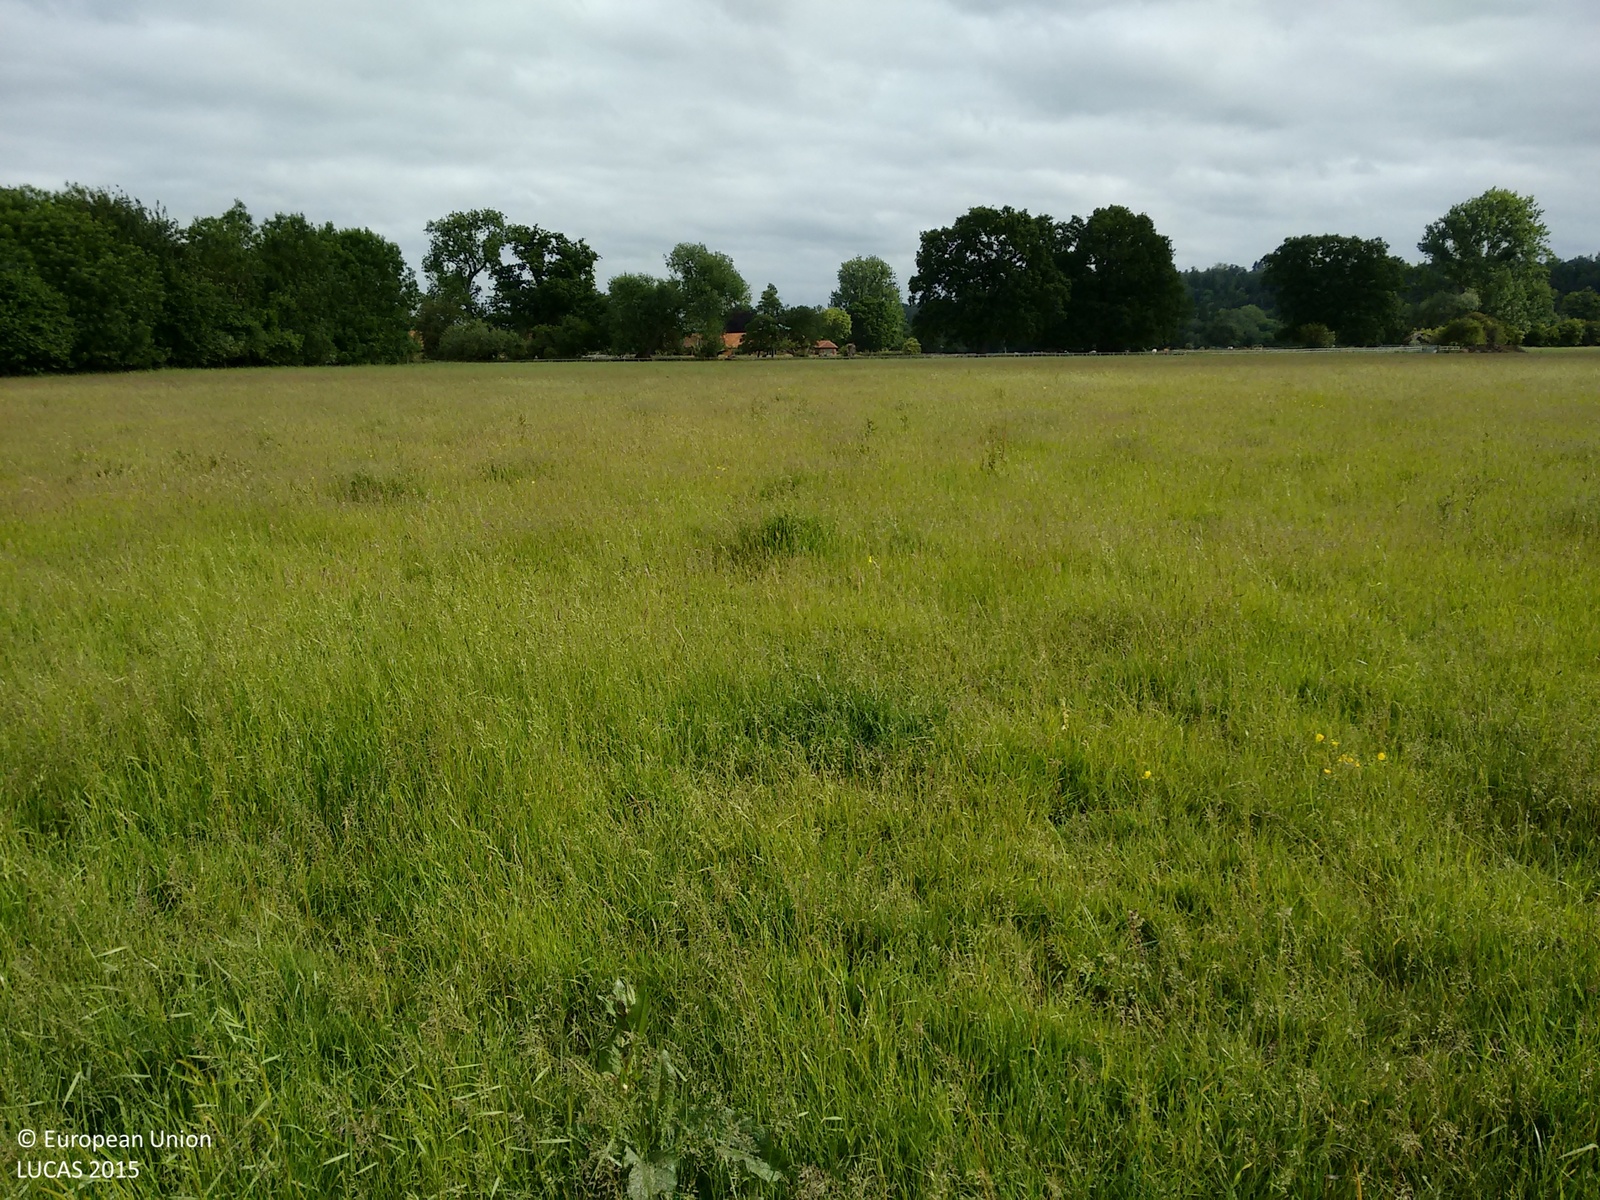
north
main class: Grassland
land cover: Grassland without tree/shrub cover
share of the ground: > 75 %
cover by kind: herbaceous plants 100 %
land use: Agriculture (excluding fallow land and kitchen gardens)
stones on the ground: < 10 %
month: June
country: GB
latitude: 51.5479
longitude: -0.6976
